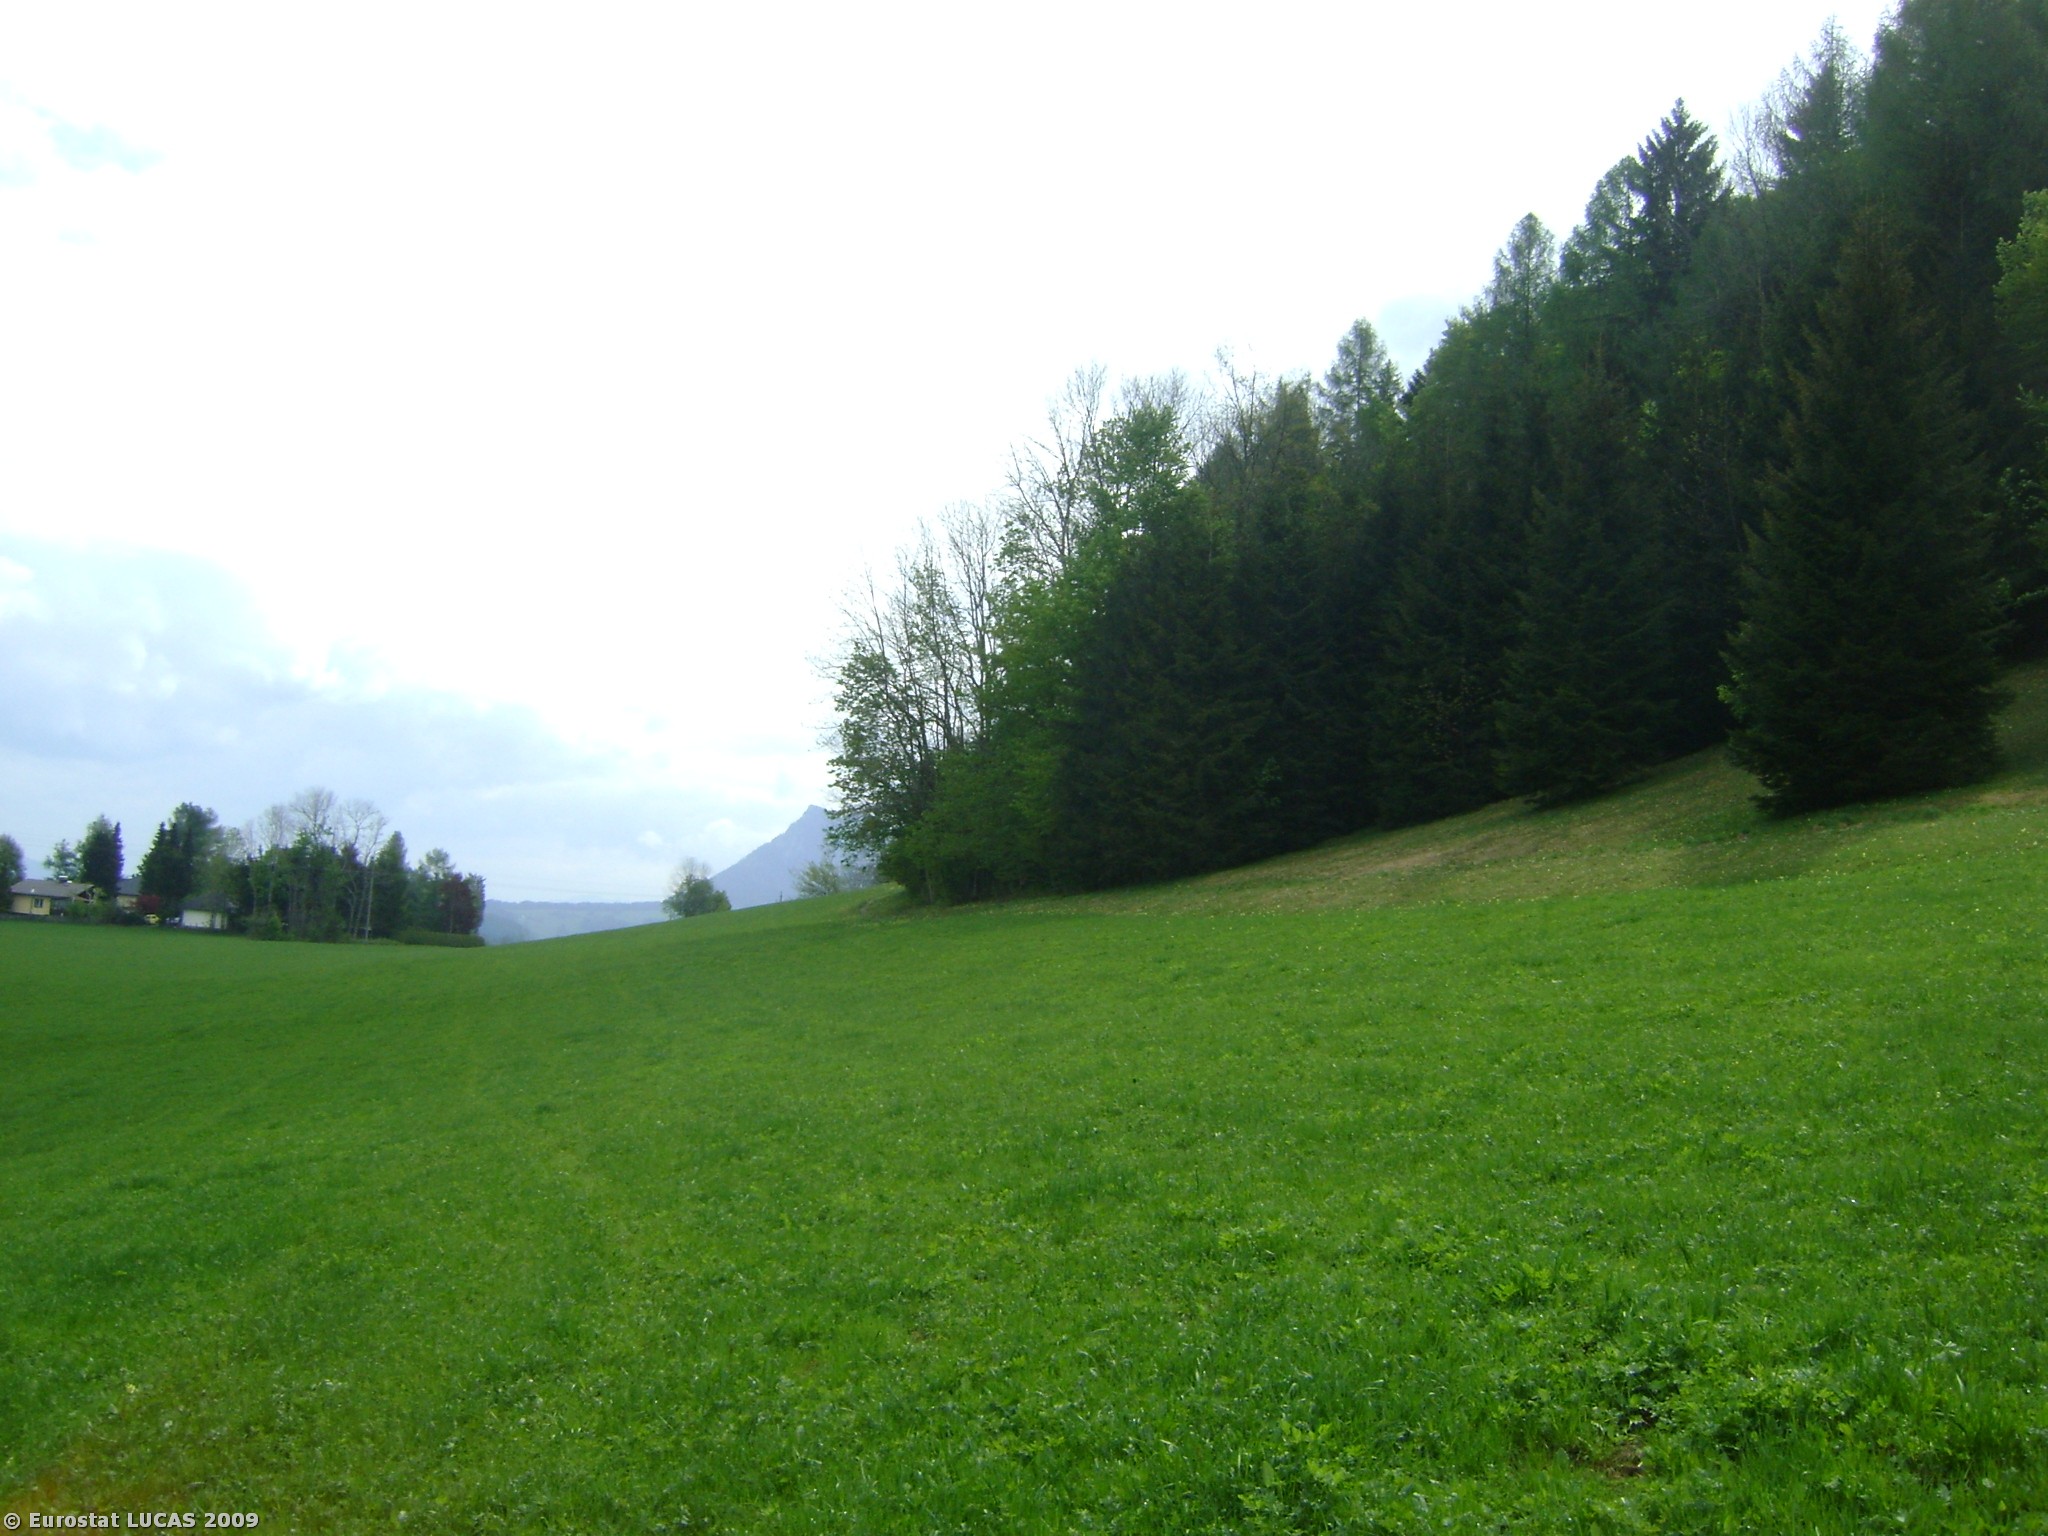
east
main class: Grassland
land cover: Grassland without tree/shrub cover
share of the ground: > 75 %
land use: Agriculture (excluding fallow land and kitchen gardens)
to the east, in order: Grassland without tree/shrub cover
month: May
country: AT
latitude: 47.8164
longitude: 13.2173
